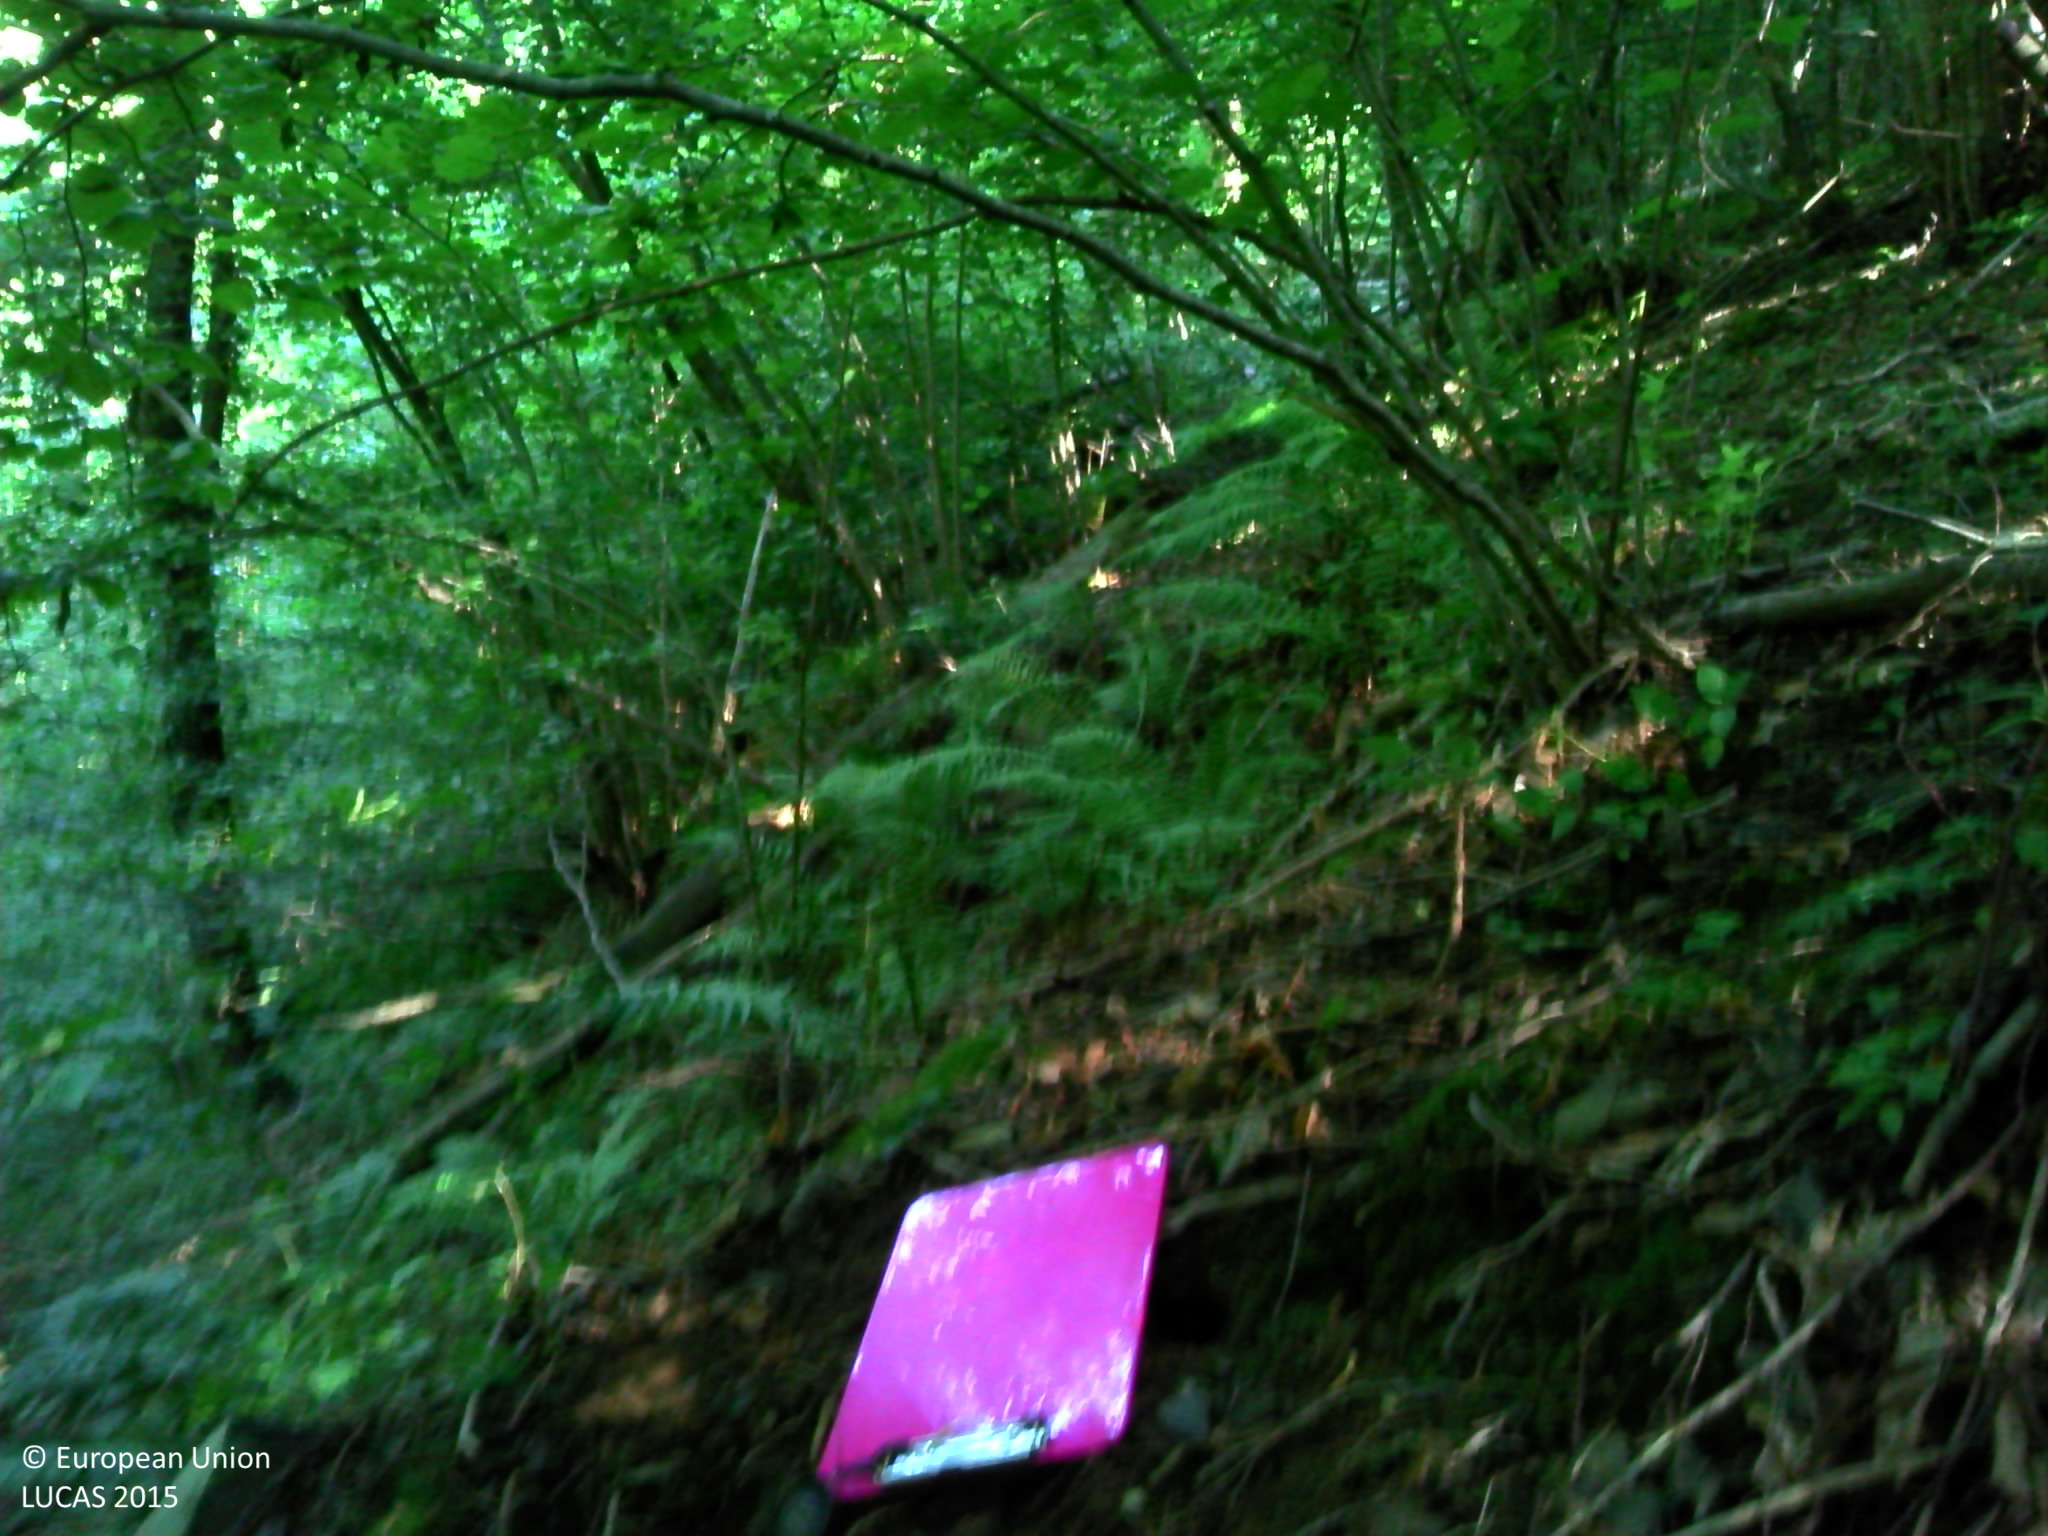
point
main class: Woodland
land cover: Broadleaved woodland
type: mesophytic deciduous forest
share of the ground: > 75 %
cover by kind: broadleaved forest trees 80 %, herbaceous plants 10 %, unconsolidated bare surface 10 %
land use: Semi-natural and natural areas not in use
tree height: > 5 m
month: August
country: FR
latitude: 42.9464
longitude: 1.4639
